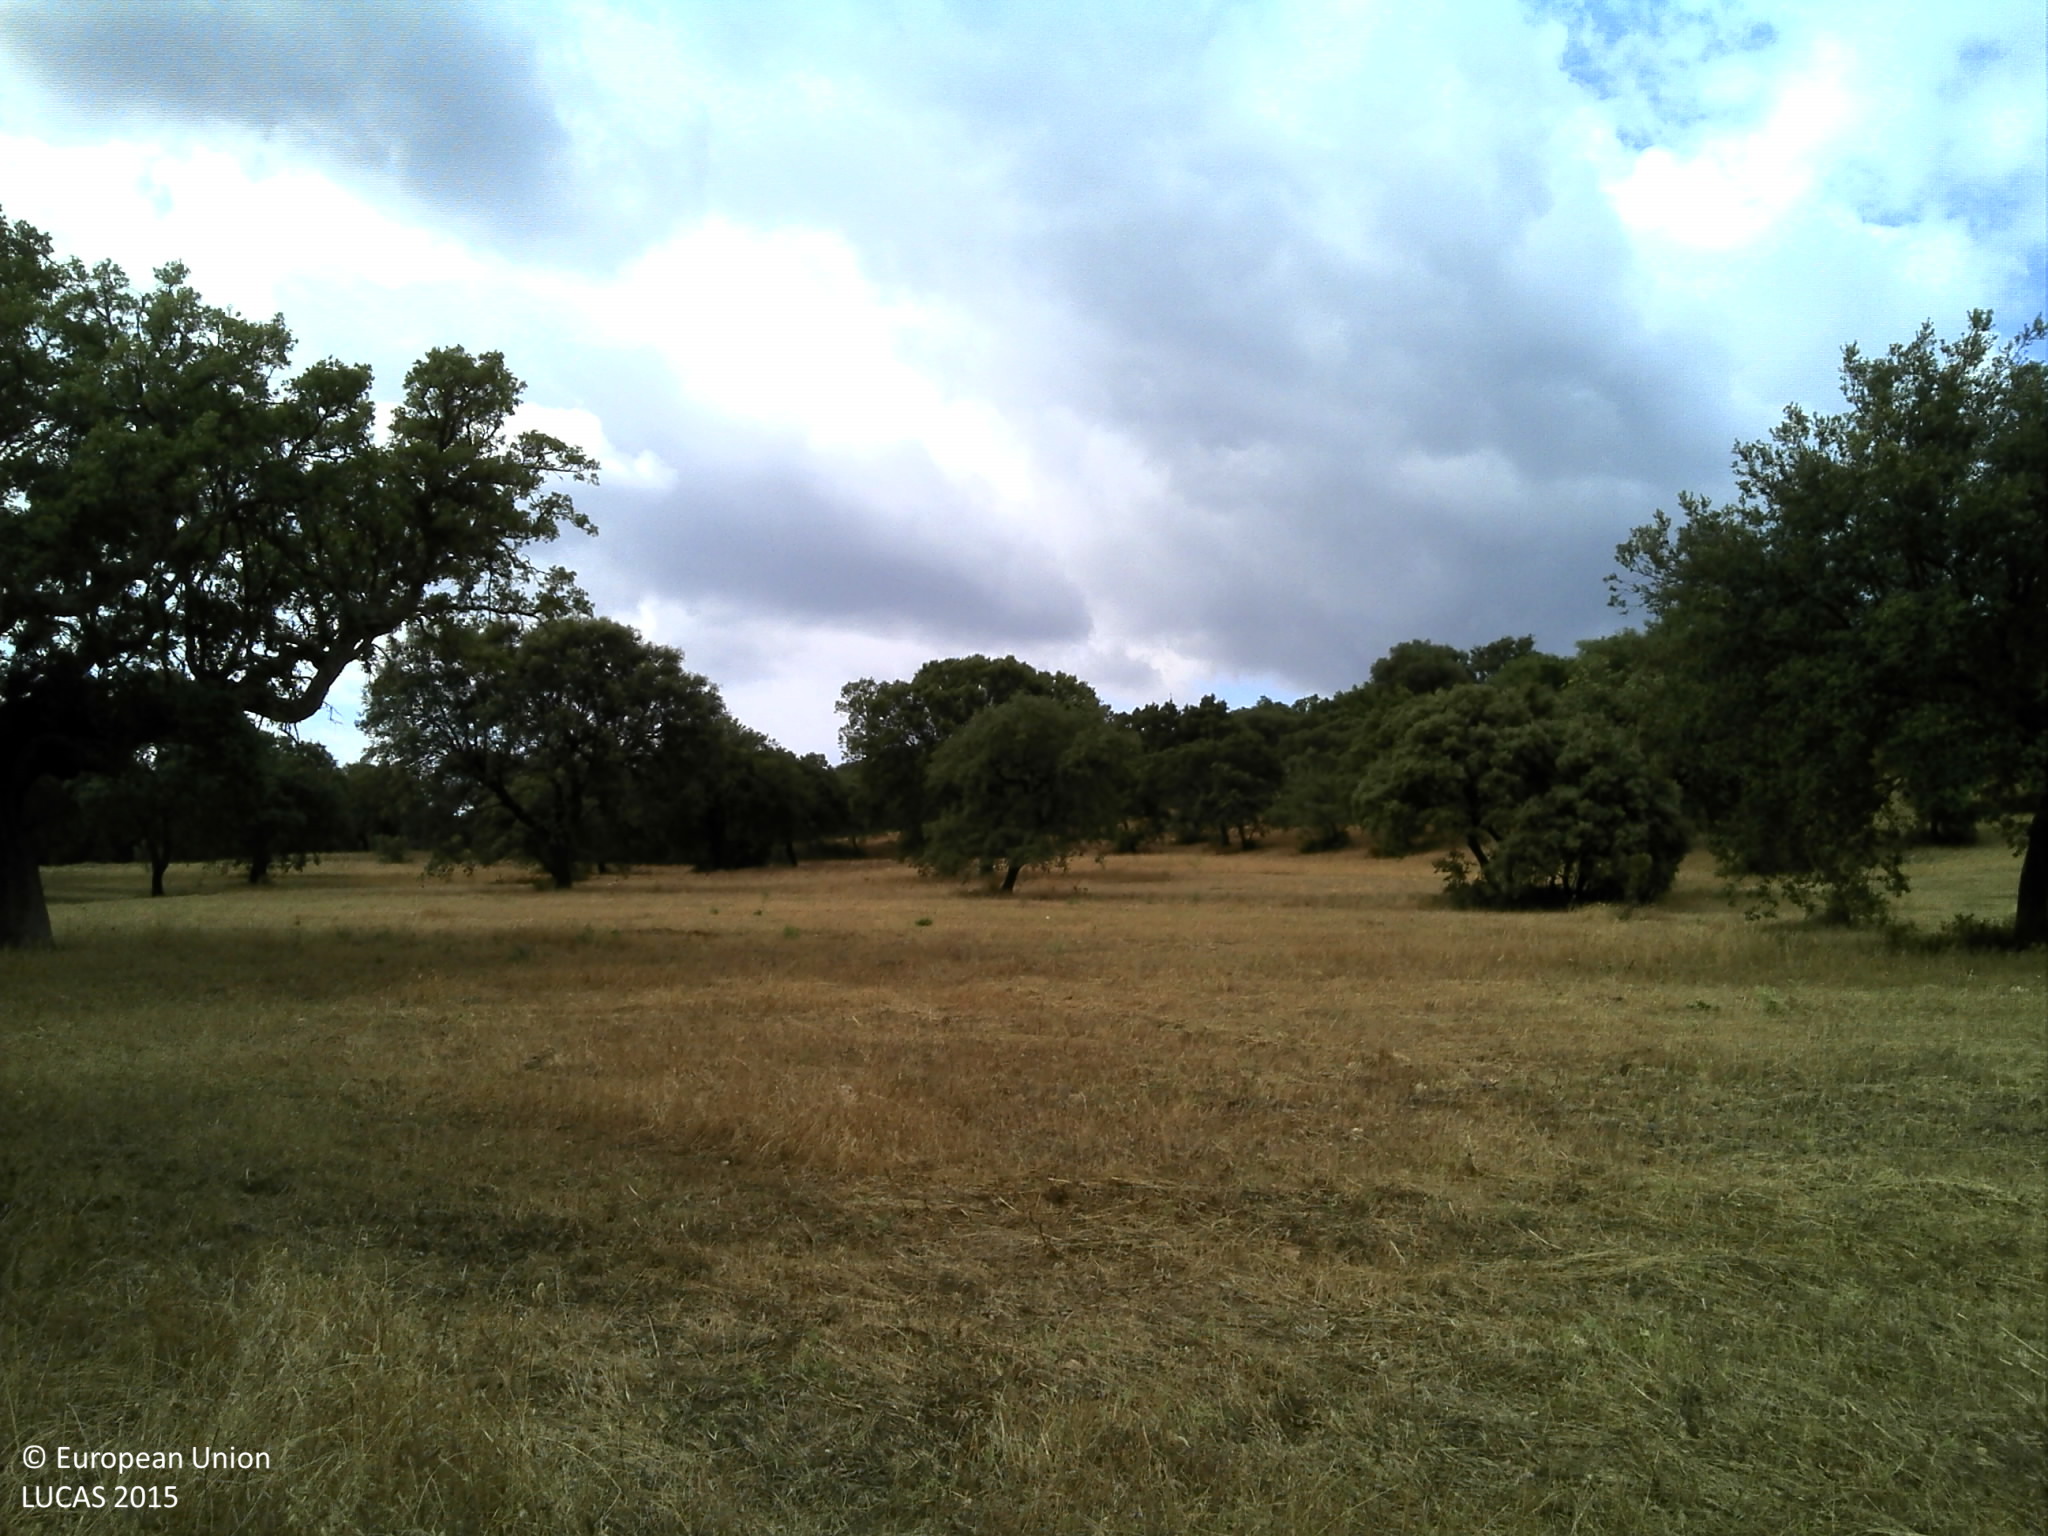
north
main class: Woodland
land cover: Broadleaved woodland
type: broadleaved evergreen forest
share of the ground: 10 - 25 %
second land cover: Other leguminous and mixtures for fodder
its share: < 10 %
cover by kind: unconsolidated bare surface 80 %, broadleaved forest trees 15 %, herbaceous plants 5 %
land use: Forestry
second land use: Agriculture (excluding fallow land and kitchen gardens)
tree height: > 5 m
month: June
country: PT
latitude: 38.5555
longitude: -8.1649
